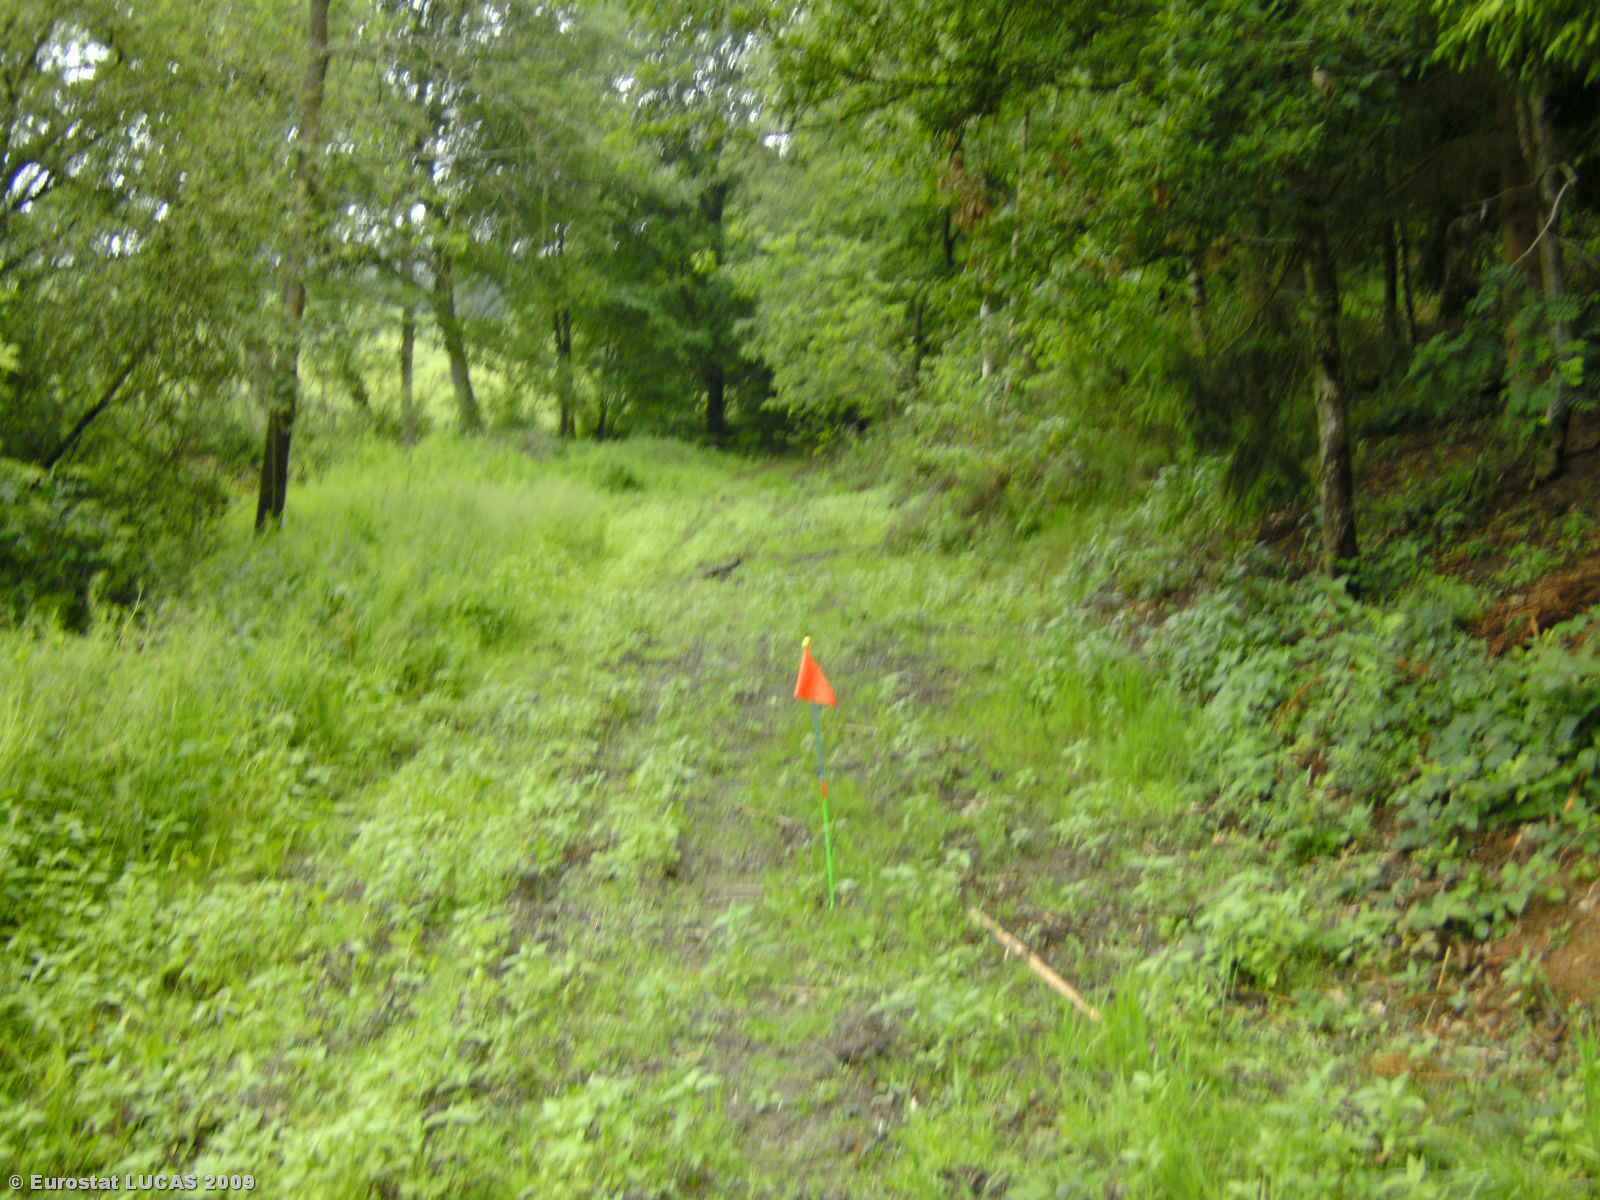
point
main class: Woodland
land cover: Coniferous woodland
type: exotic forest
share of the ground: > 75 %
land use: Forestry
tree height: > 5 m
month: June
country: LU
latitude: 49.9918
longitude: 6.1076
